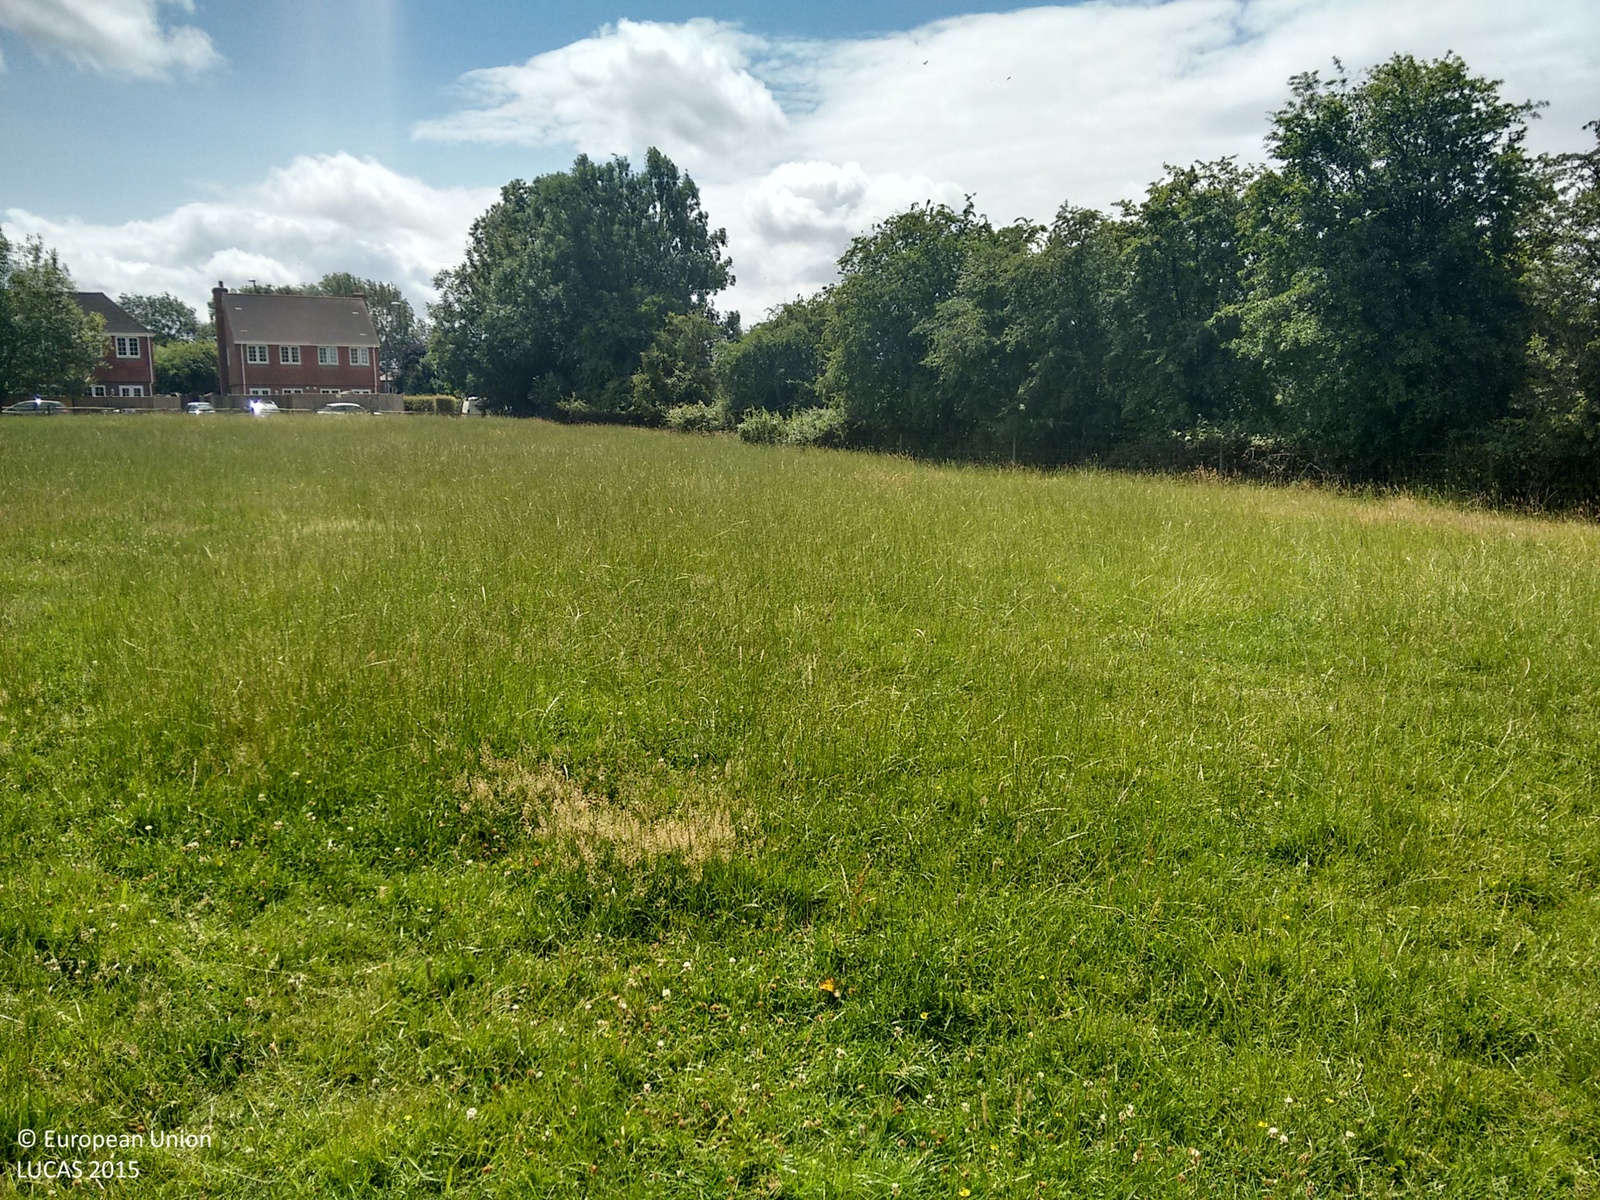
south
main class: Grassland
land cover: Grassland without tree/shrub cover
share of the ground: > 75 %
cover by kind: herbaceous plants 100 %
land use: Residential
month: July
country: GB
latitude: 51.0459
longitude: -0.4359
